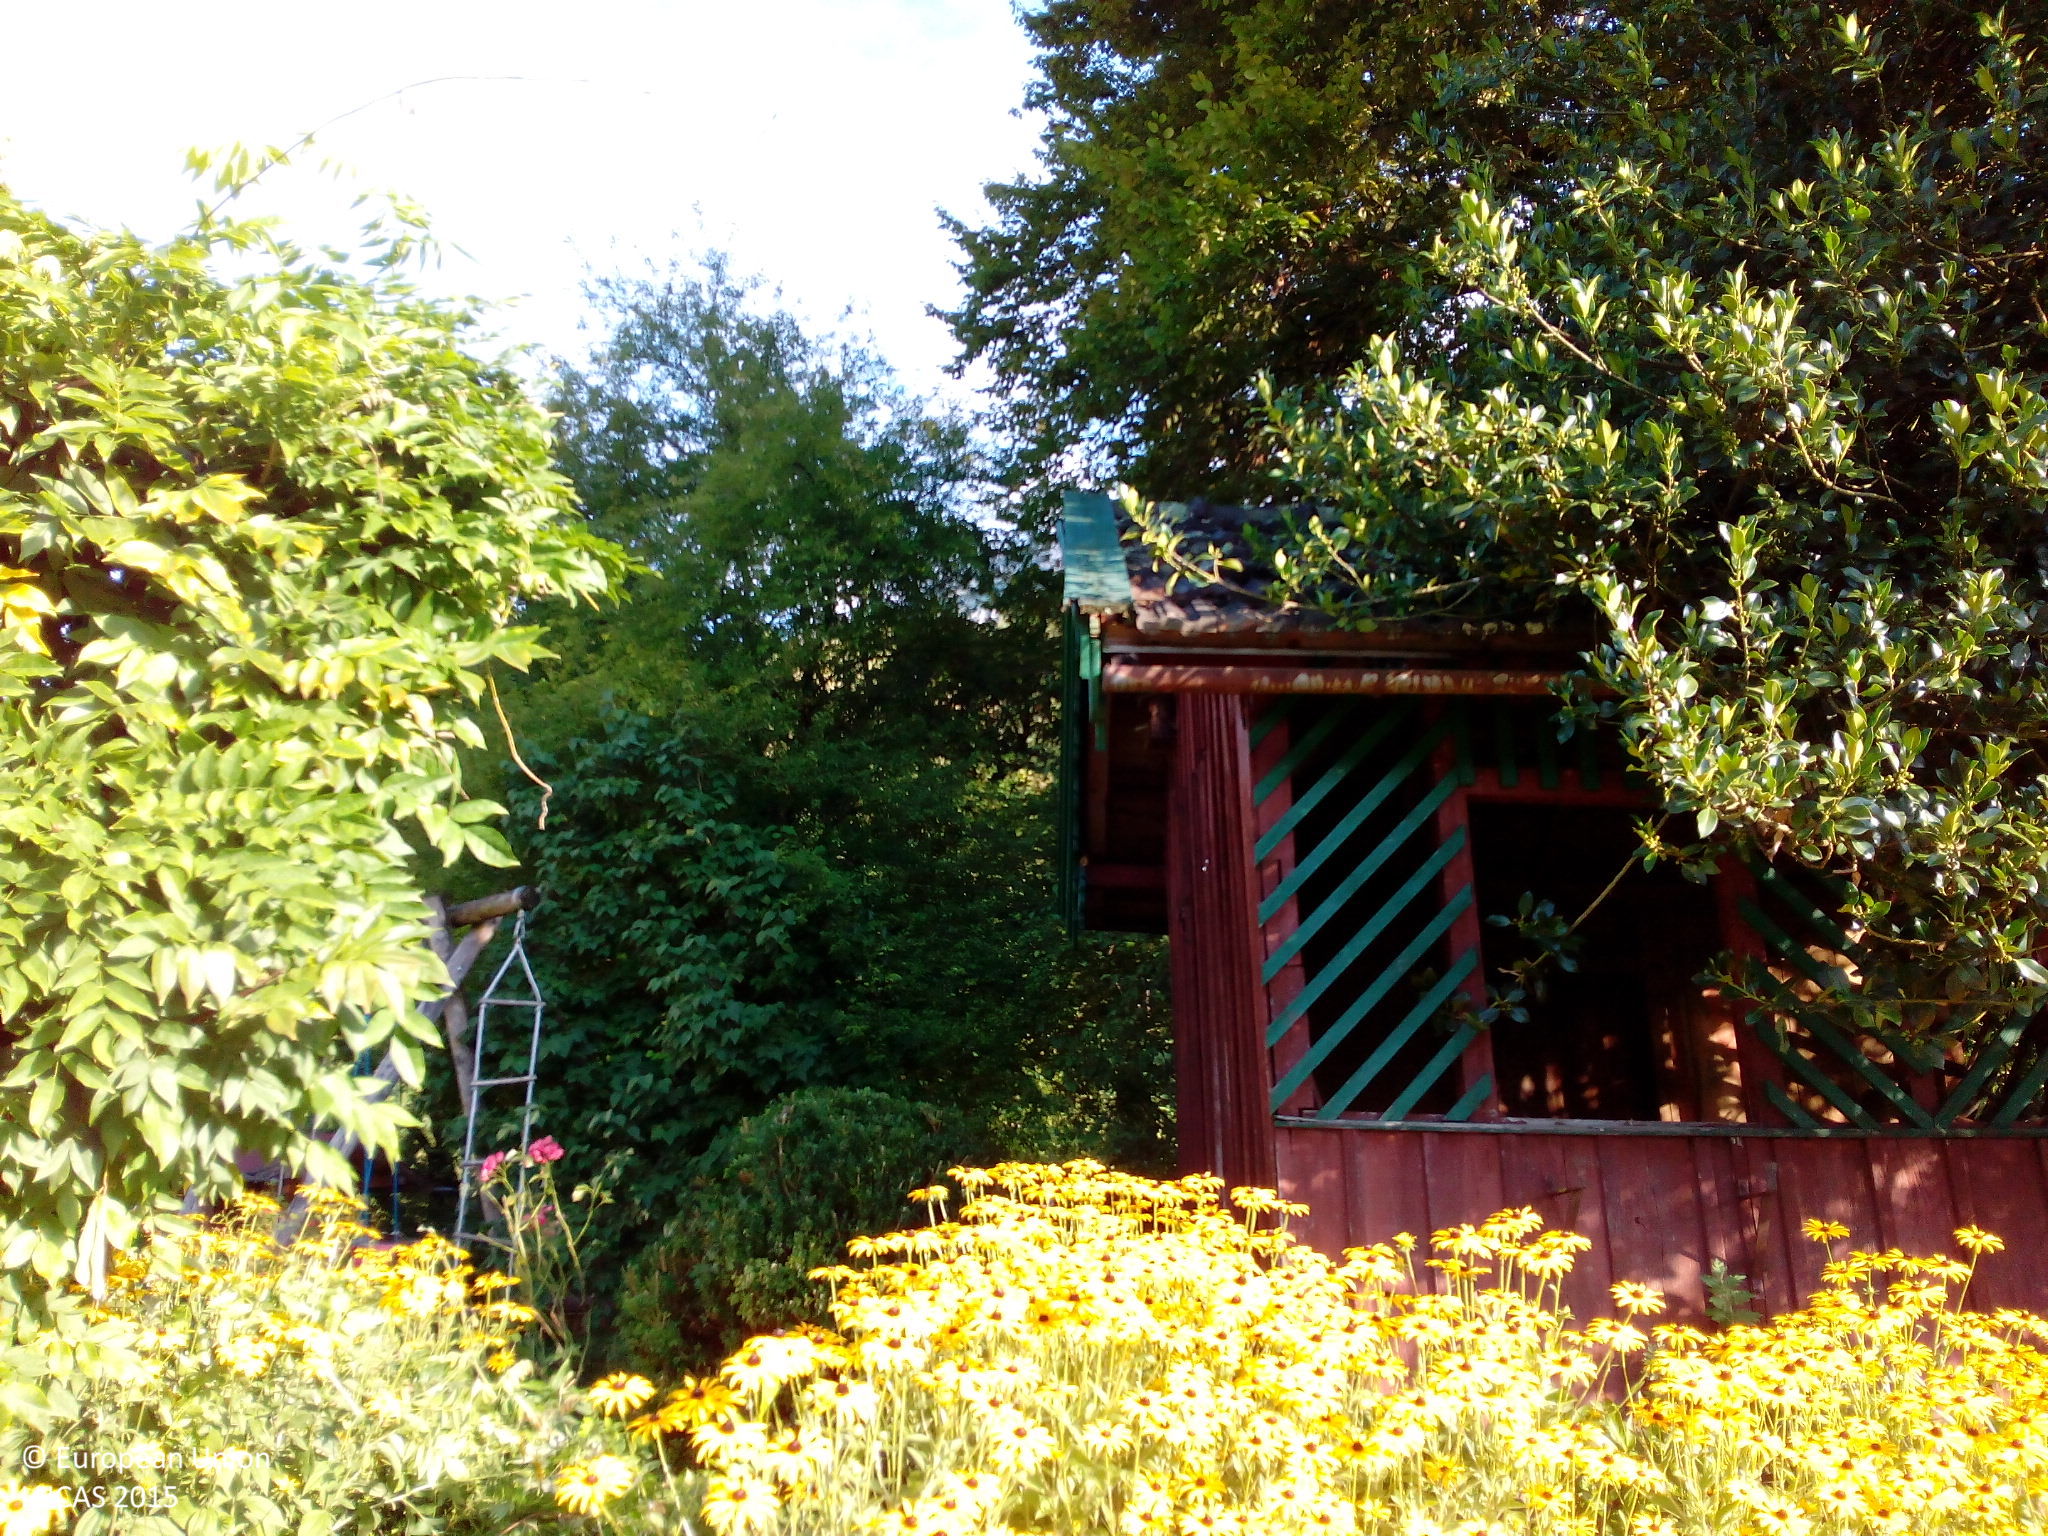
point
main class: Woodland
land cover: Broadleaved woodland
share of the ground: > 75 %
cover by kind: broadleaved forest trees 75 %, herbaceous plants 25 %
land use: Residential
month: August
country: DE
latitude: 47.7361
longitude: 12.8655
